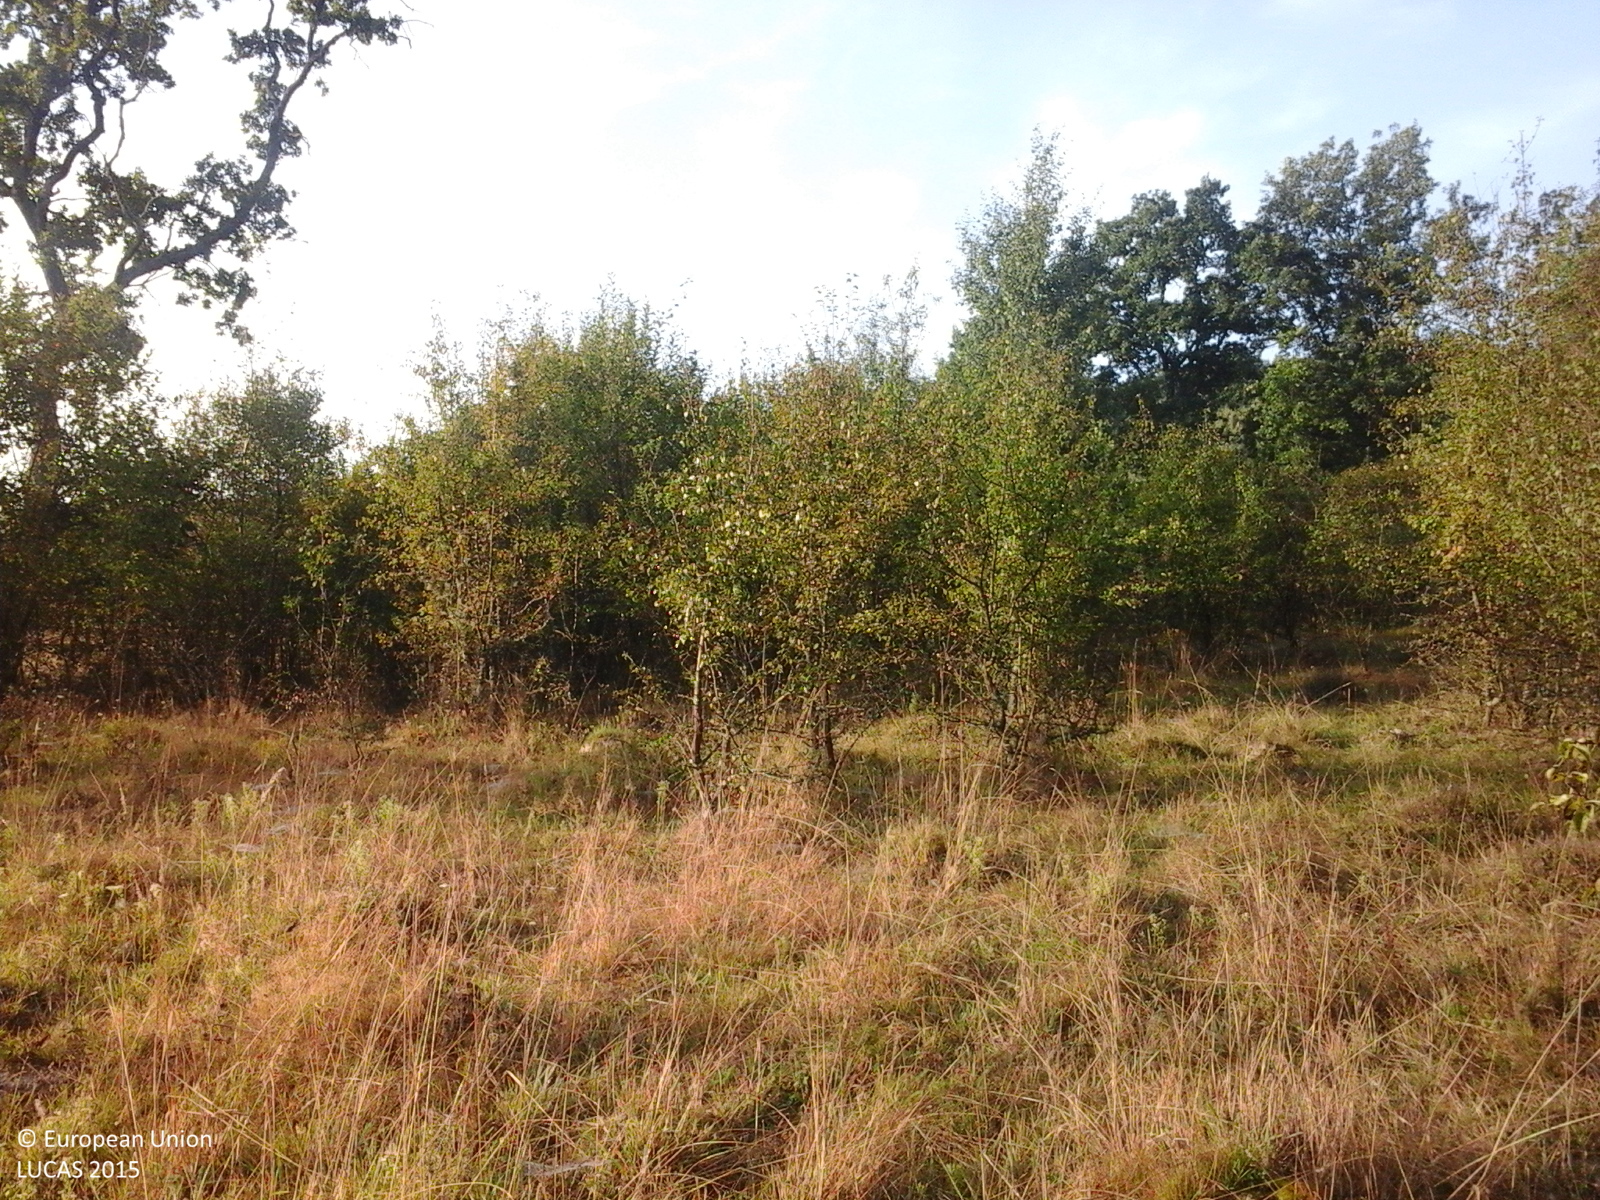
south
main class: Grassland
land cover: Grassland with sparse tree/shrub cover
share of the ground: > 75 %
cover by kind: herbaceous plants 85 %, shrubs 10 %, broadleaved forest trees 5 %
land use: Agriculture (excluding fallow land and kitchen gardens)
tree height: > 5 m
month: September
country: RO
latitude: 46.8947
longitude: 23.3638
